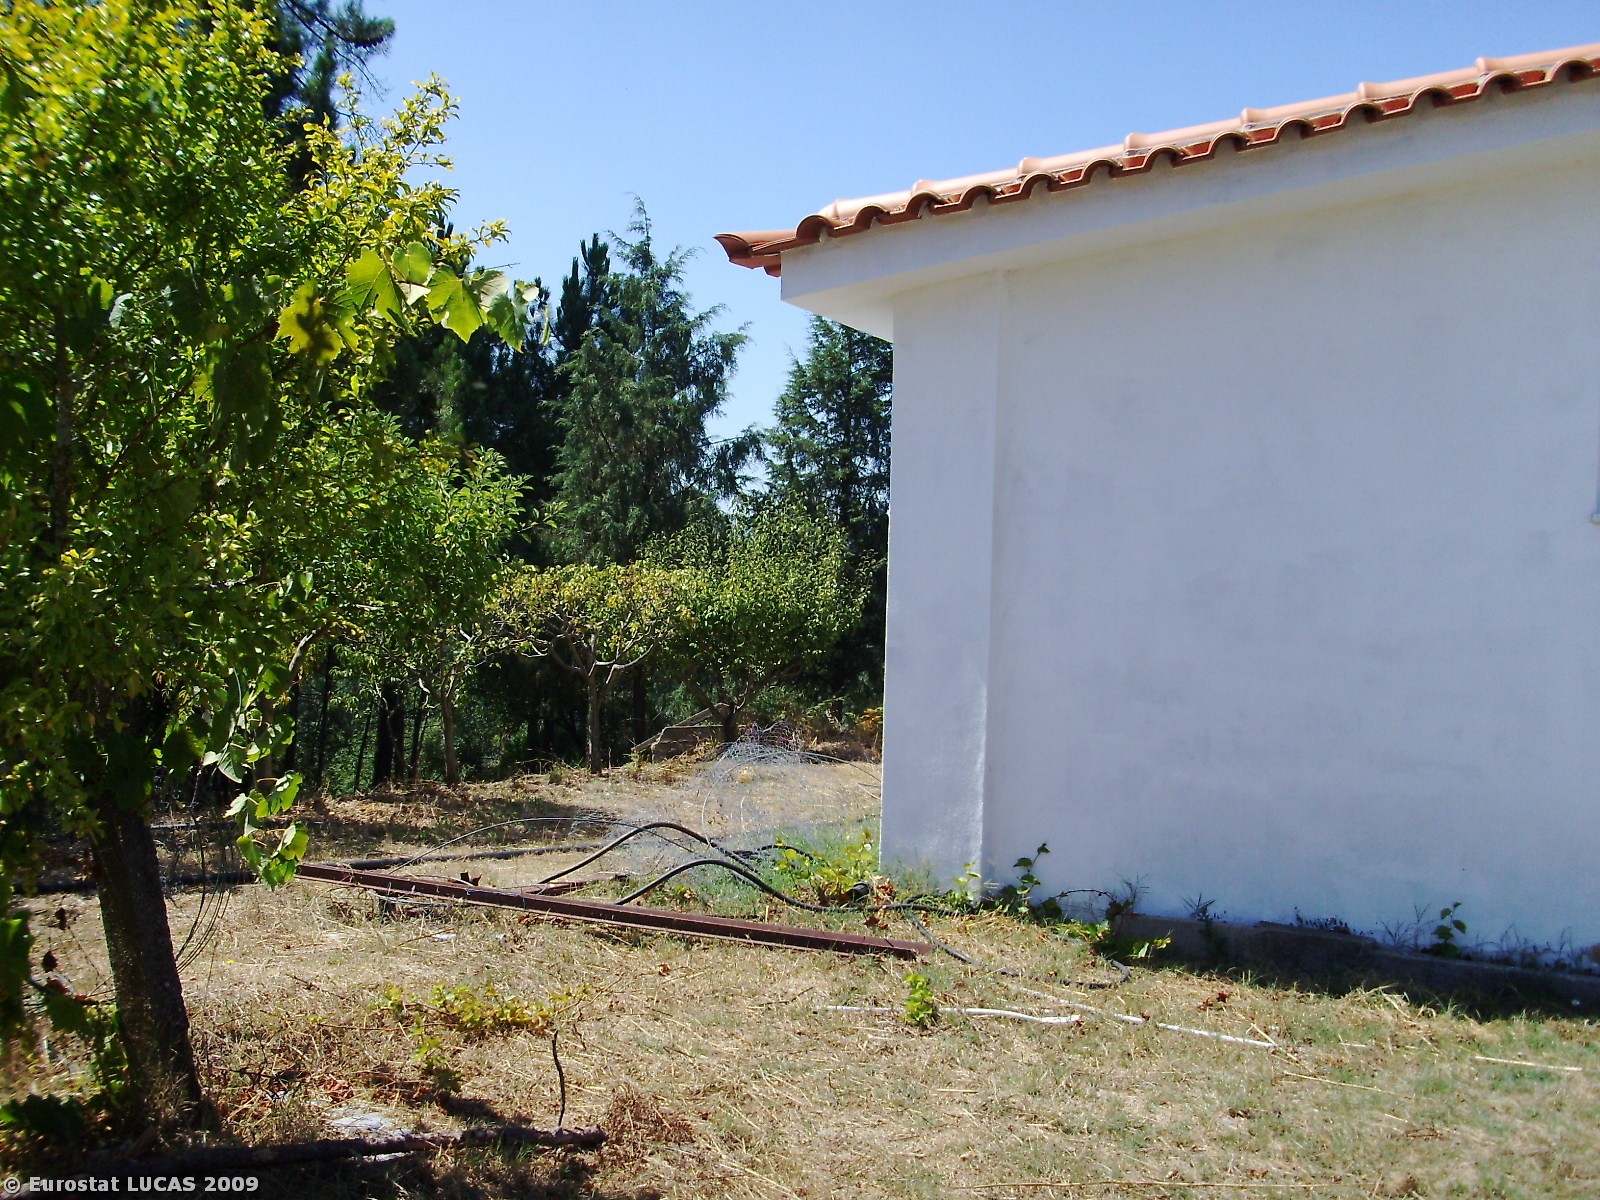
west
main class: Grassland
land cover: Spontaneously vegetated surfaces
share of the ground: > 75 %
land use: Fallow land
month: August
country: PT
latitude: 40.1894
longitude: -8.2248
